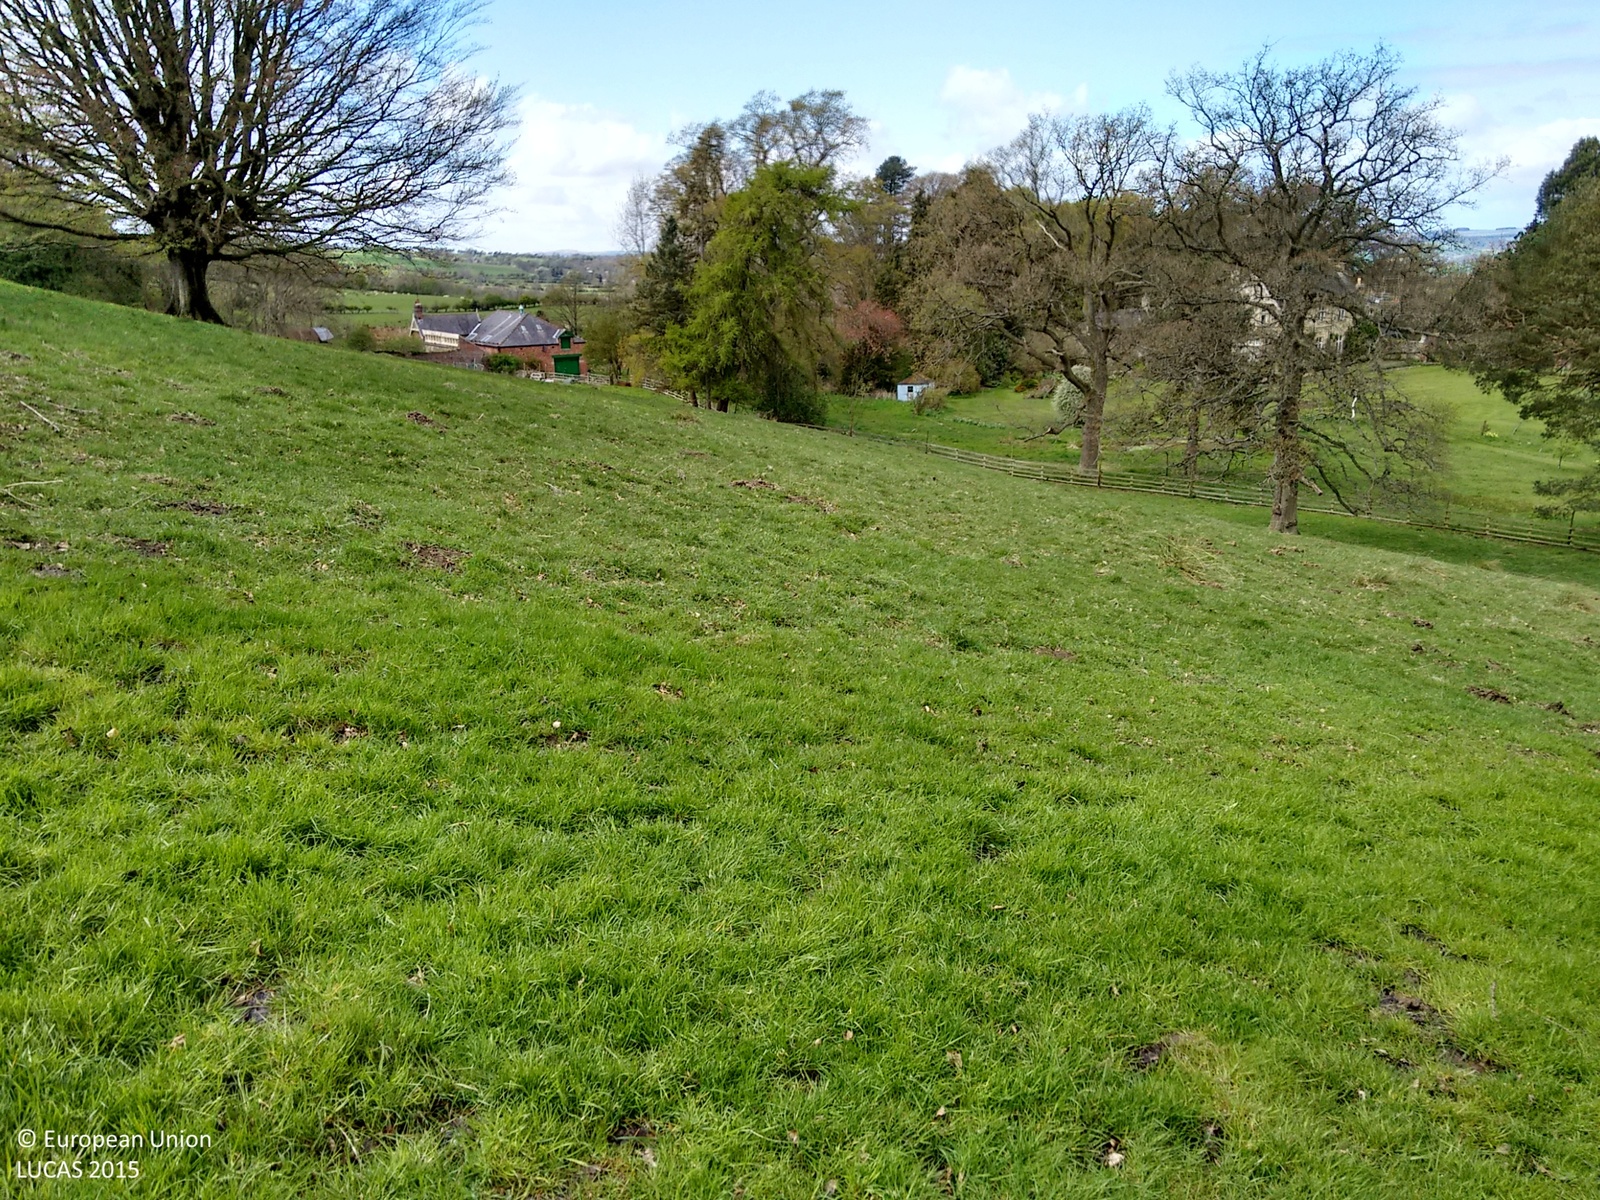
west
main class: Woodland
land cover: Broadleaved woodland
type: acidophilous oak and oak-birch forest
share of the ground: > 75 %
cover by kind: broadleaved forest trees 100 %
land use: Forestry
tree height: > 5 m
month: May
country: GB
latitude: 54.9577
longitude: -2.0965
